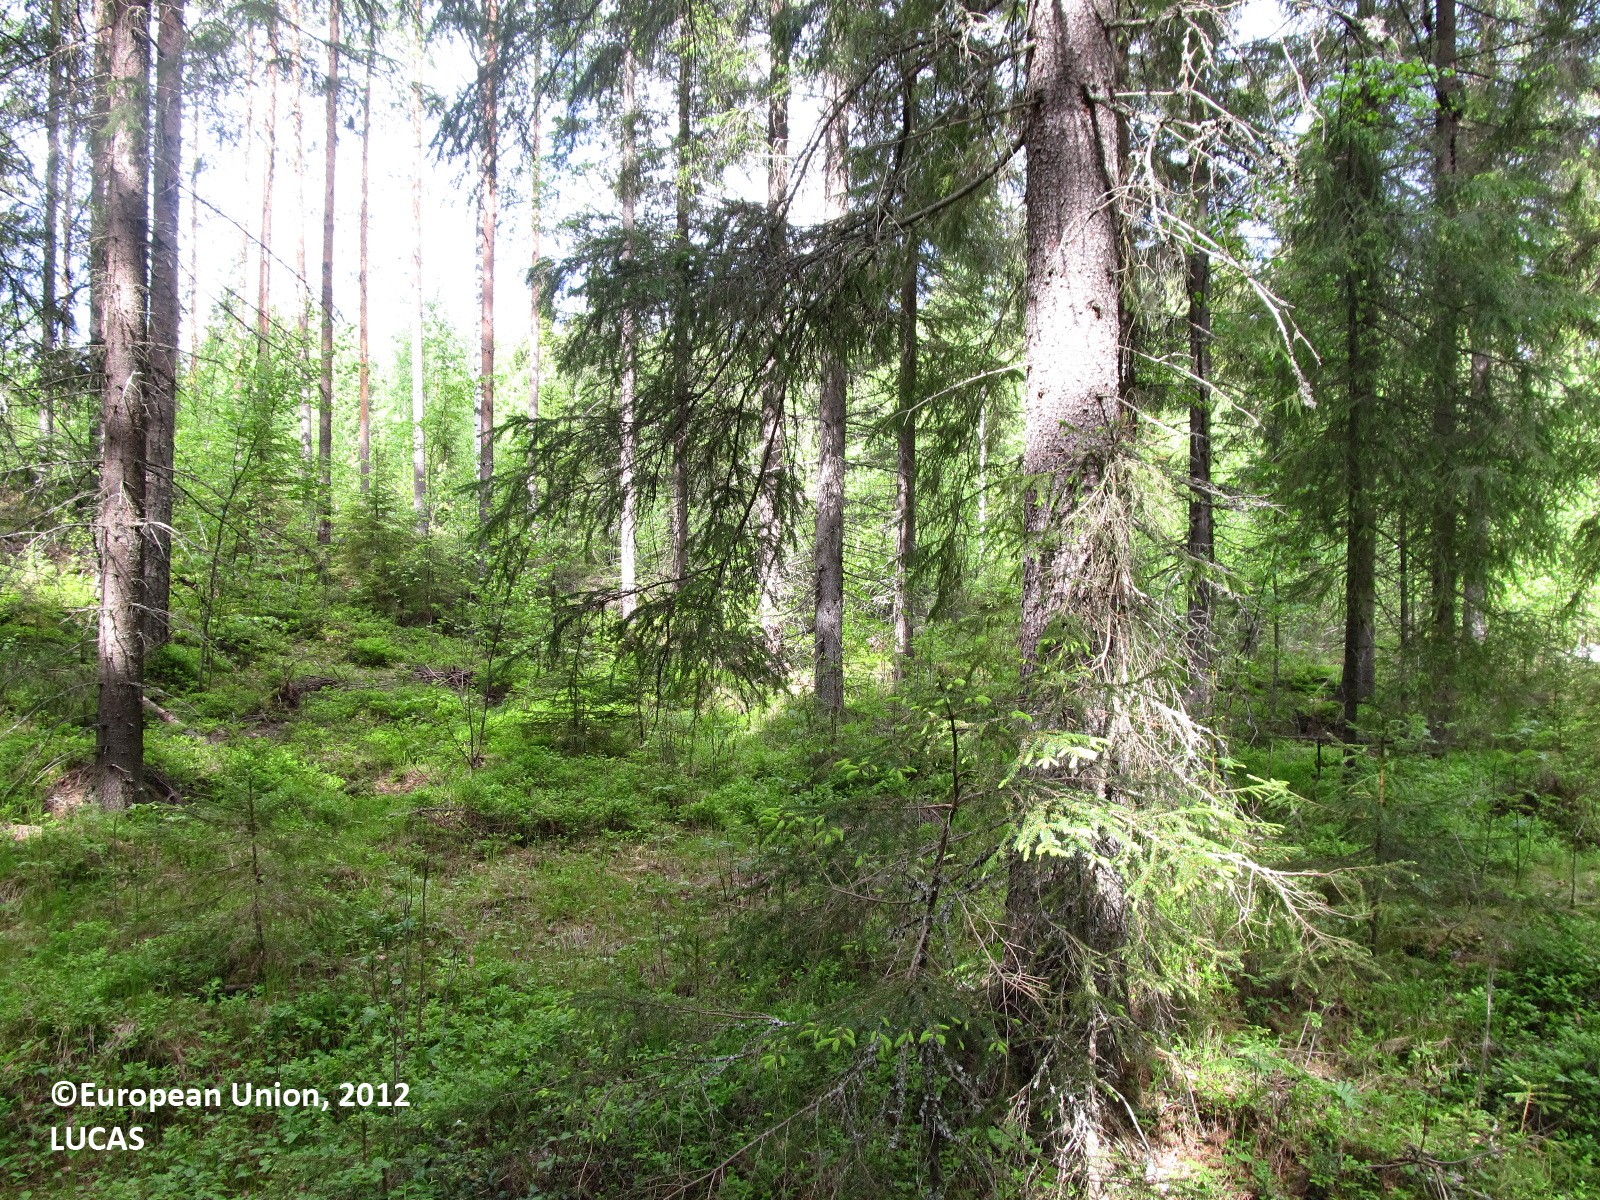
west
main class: Woodland
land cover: Spruce dominated coniferous woodland
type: boreal forest
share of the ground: 25 - 50 %
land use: Forestry
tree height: > 5 m
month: June
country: FI
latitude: 62.5361
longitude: 29.1763
